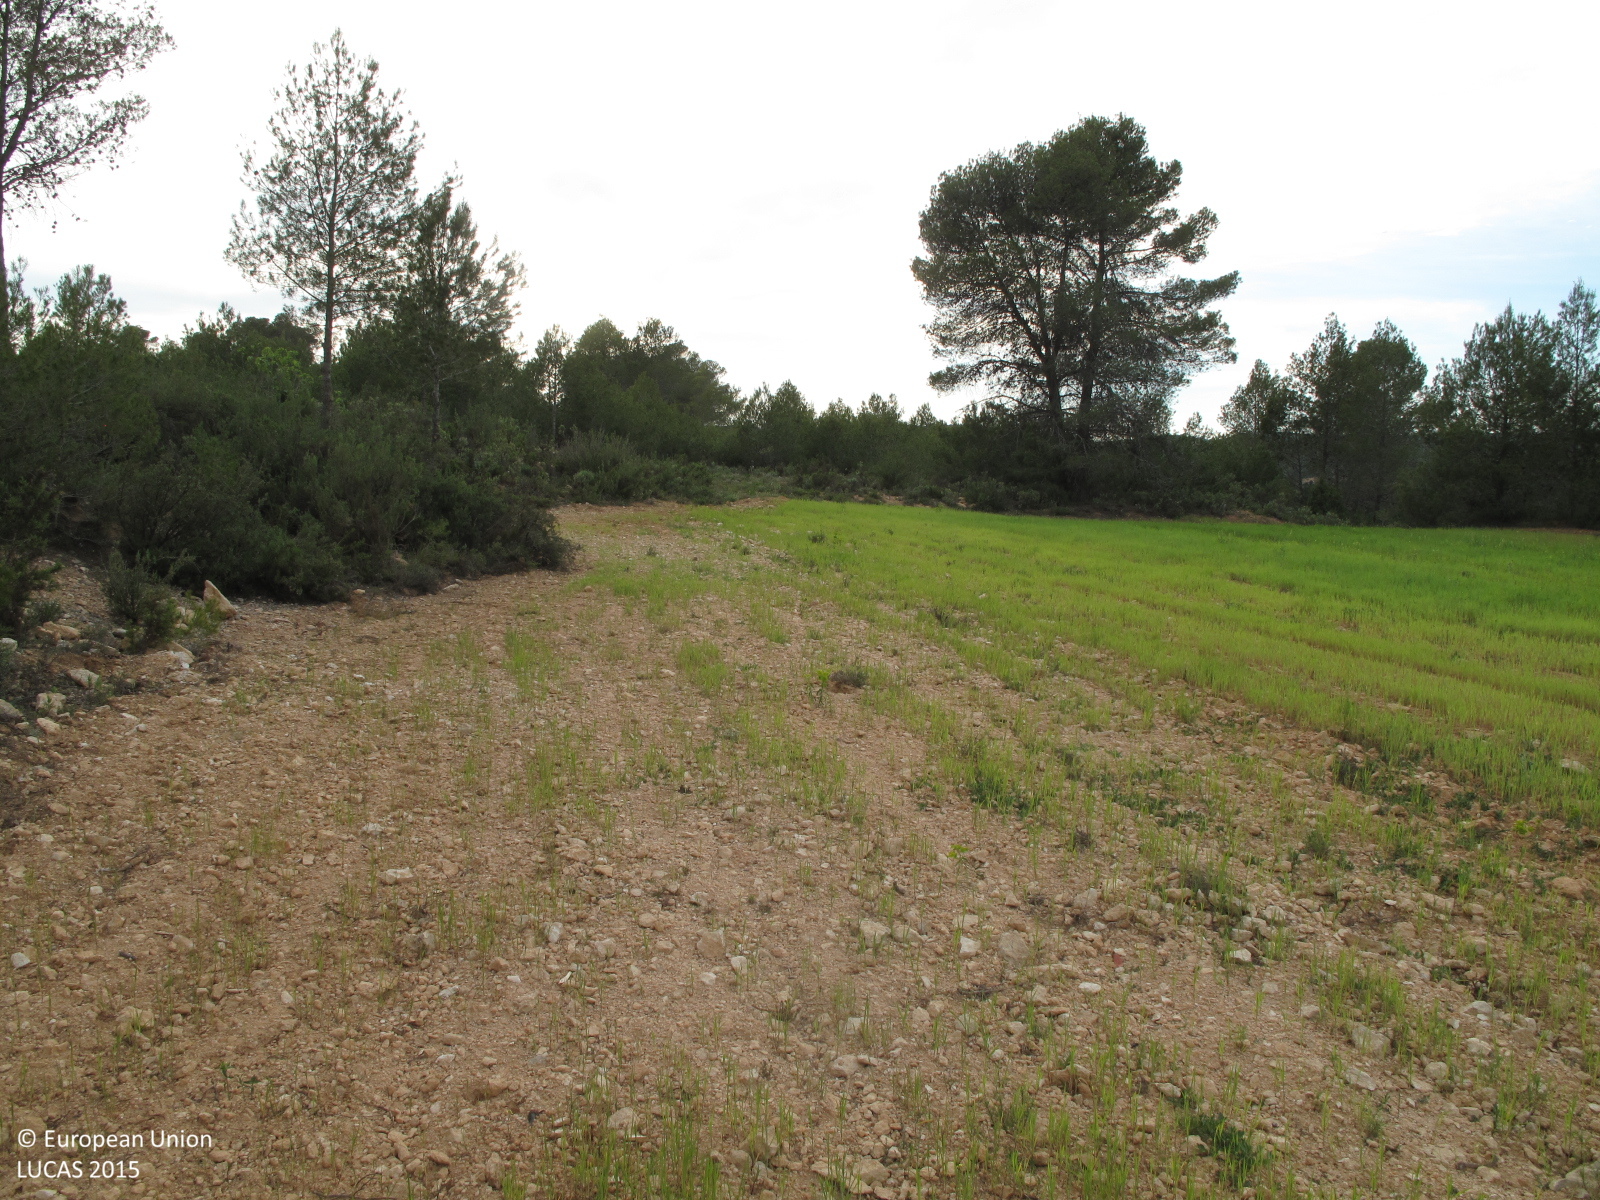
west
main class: Cropland
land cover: Common wheat
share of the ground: 50 - 75 %
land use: Agriculture (excluding fallow land and kitchen gardens)
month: May
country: ES
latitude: 38.7853
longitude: -0.7089
